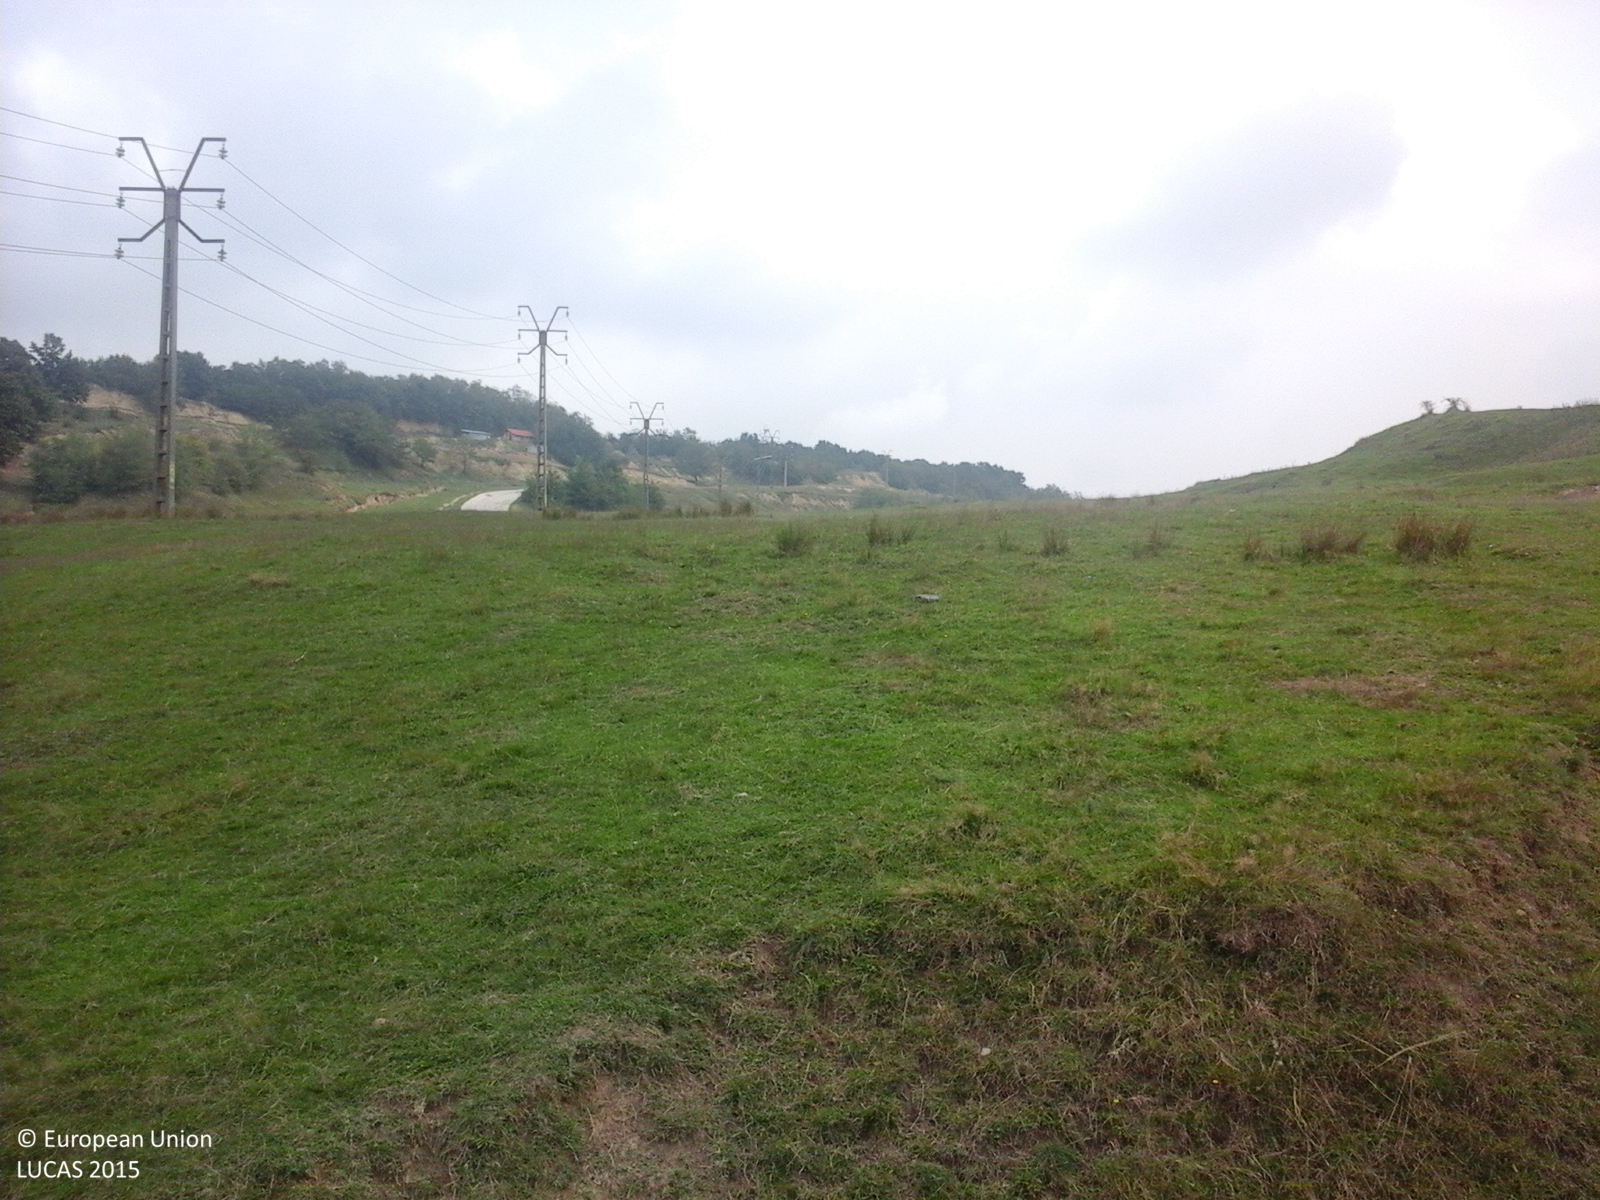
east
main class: Grassland
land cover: Grassland without tree/shrub cover
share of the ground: > 75 %
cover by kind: herbaceous plants 100 %
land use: Agriculture (excluding fallow land and kitchen gardens)
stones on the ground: < 10 %
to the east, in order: Grassland without tree/shrub cover; Ditches and canals; Grassland without tree/shrub cover; Paved roads, cycling and walking lanes; Grassland without tree/shrub cover; Inland marshes; Grassland without tree/shrub cover
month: September
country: RO
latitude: 44.9407
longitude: 23.0906
